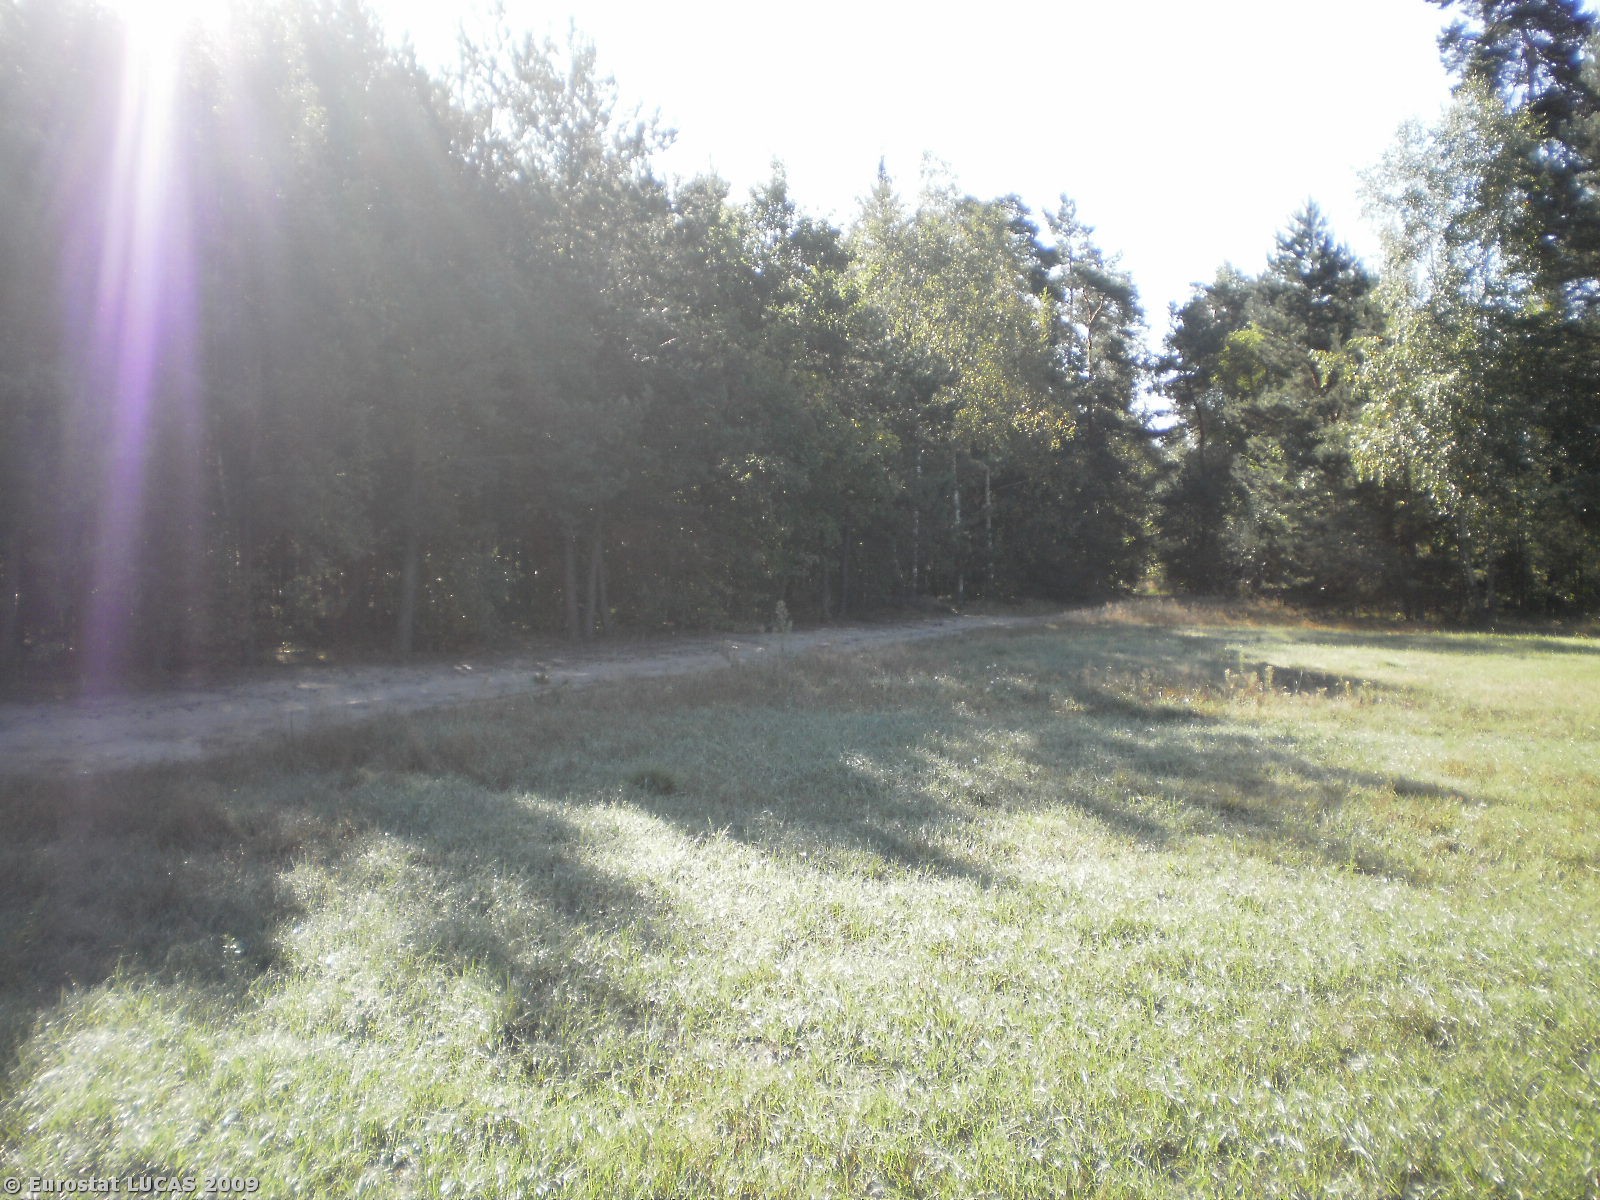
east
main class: Grassland
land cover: Grassland without tree/shrub cover
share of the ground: > 75 %
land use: Agriculture (excluding fallow land and kitchen gardens)
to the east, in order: Grassland without tree/shrub cover; Tracks; Mixed woodland; Coniferous woodland; Tracks; Coniferous woodland
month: August
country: PL
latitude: 52.6079
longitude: 21.7649
